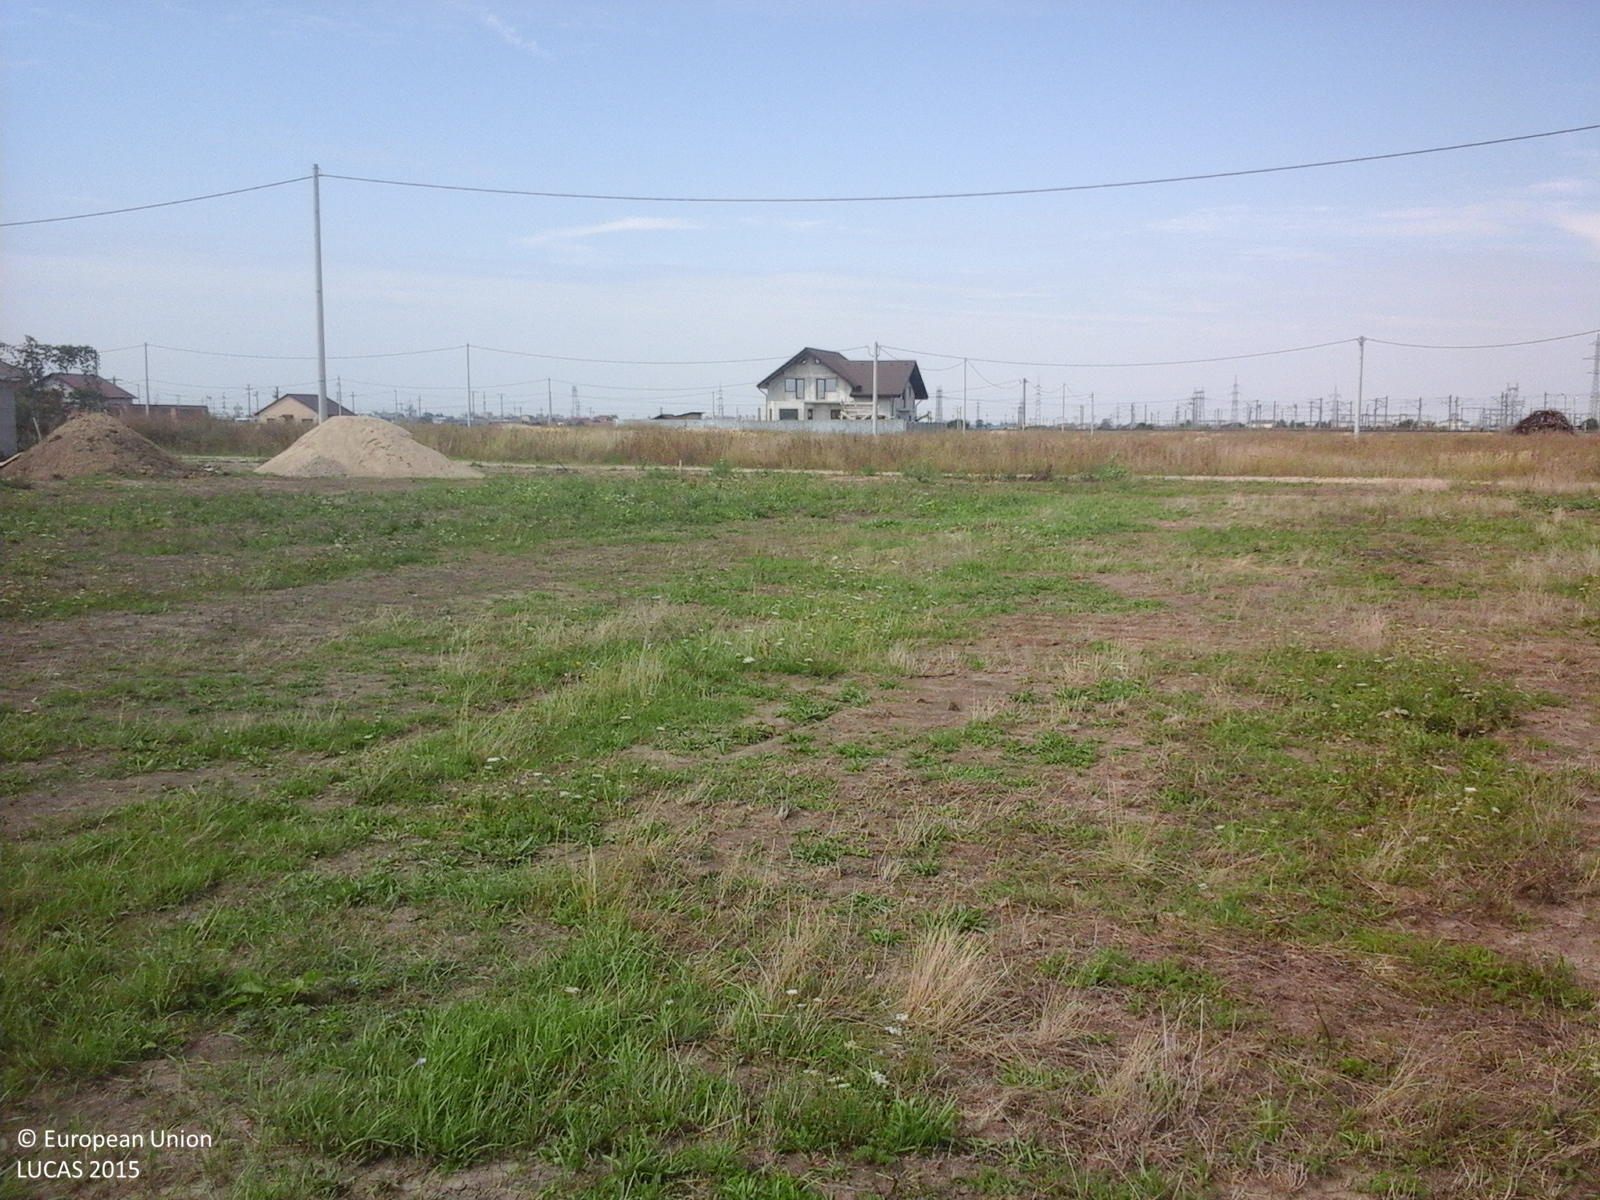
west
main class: Grassland
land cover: Grassland without tree/shrub cover
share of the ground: > 75 %
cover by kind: herbaceous plants 100 %
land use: Agriculture (excluding fallow land and kitchen gardens)
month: August
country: RO
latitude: 46.1765
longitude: 21.3952
